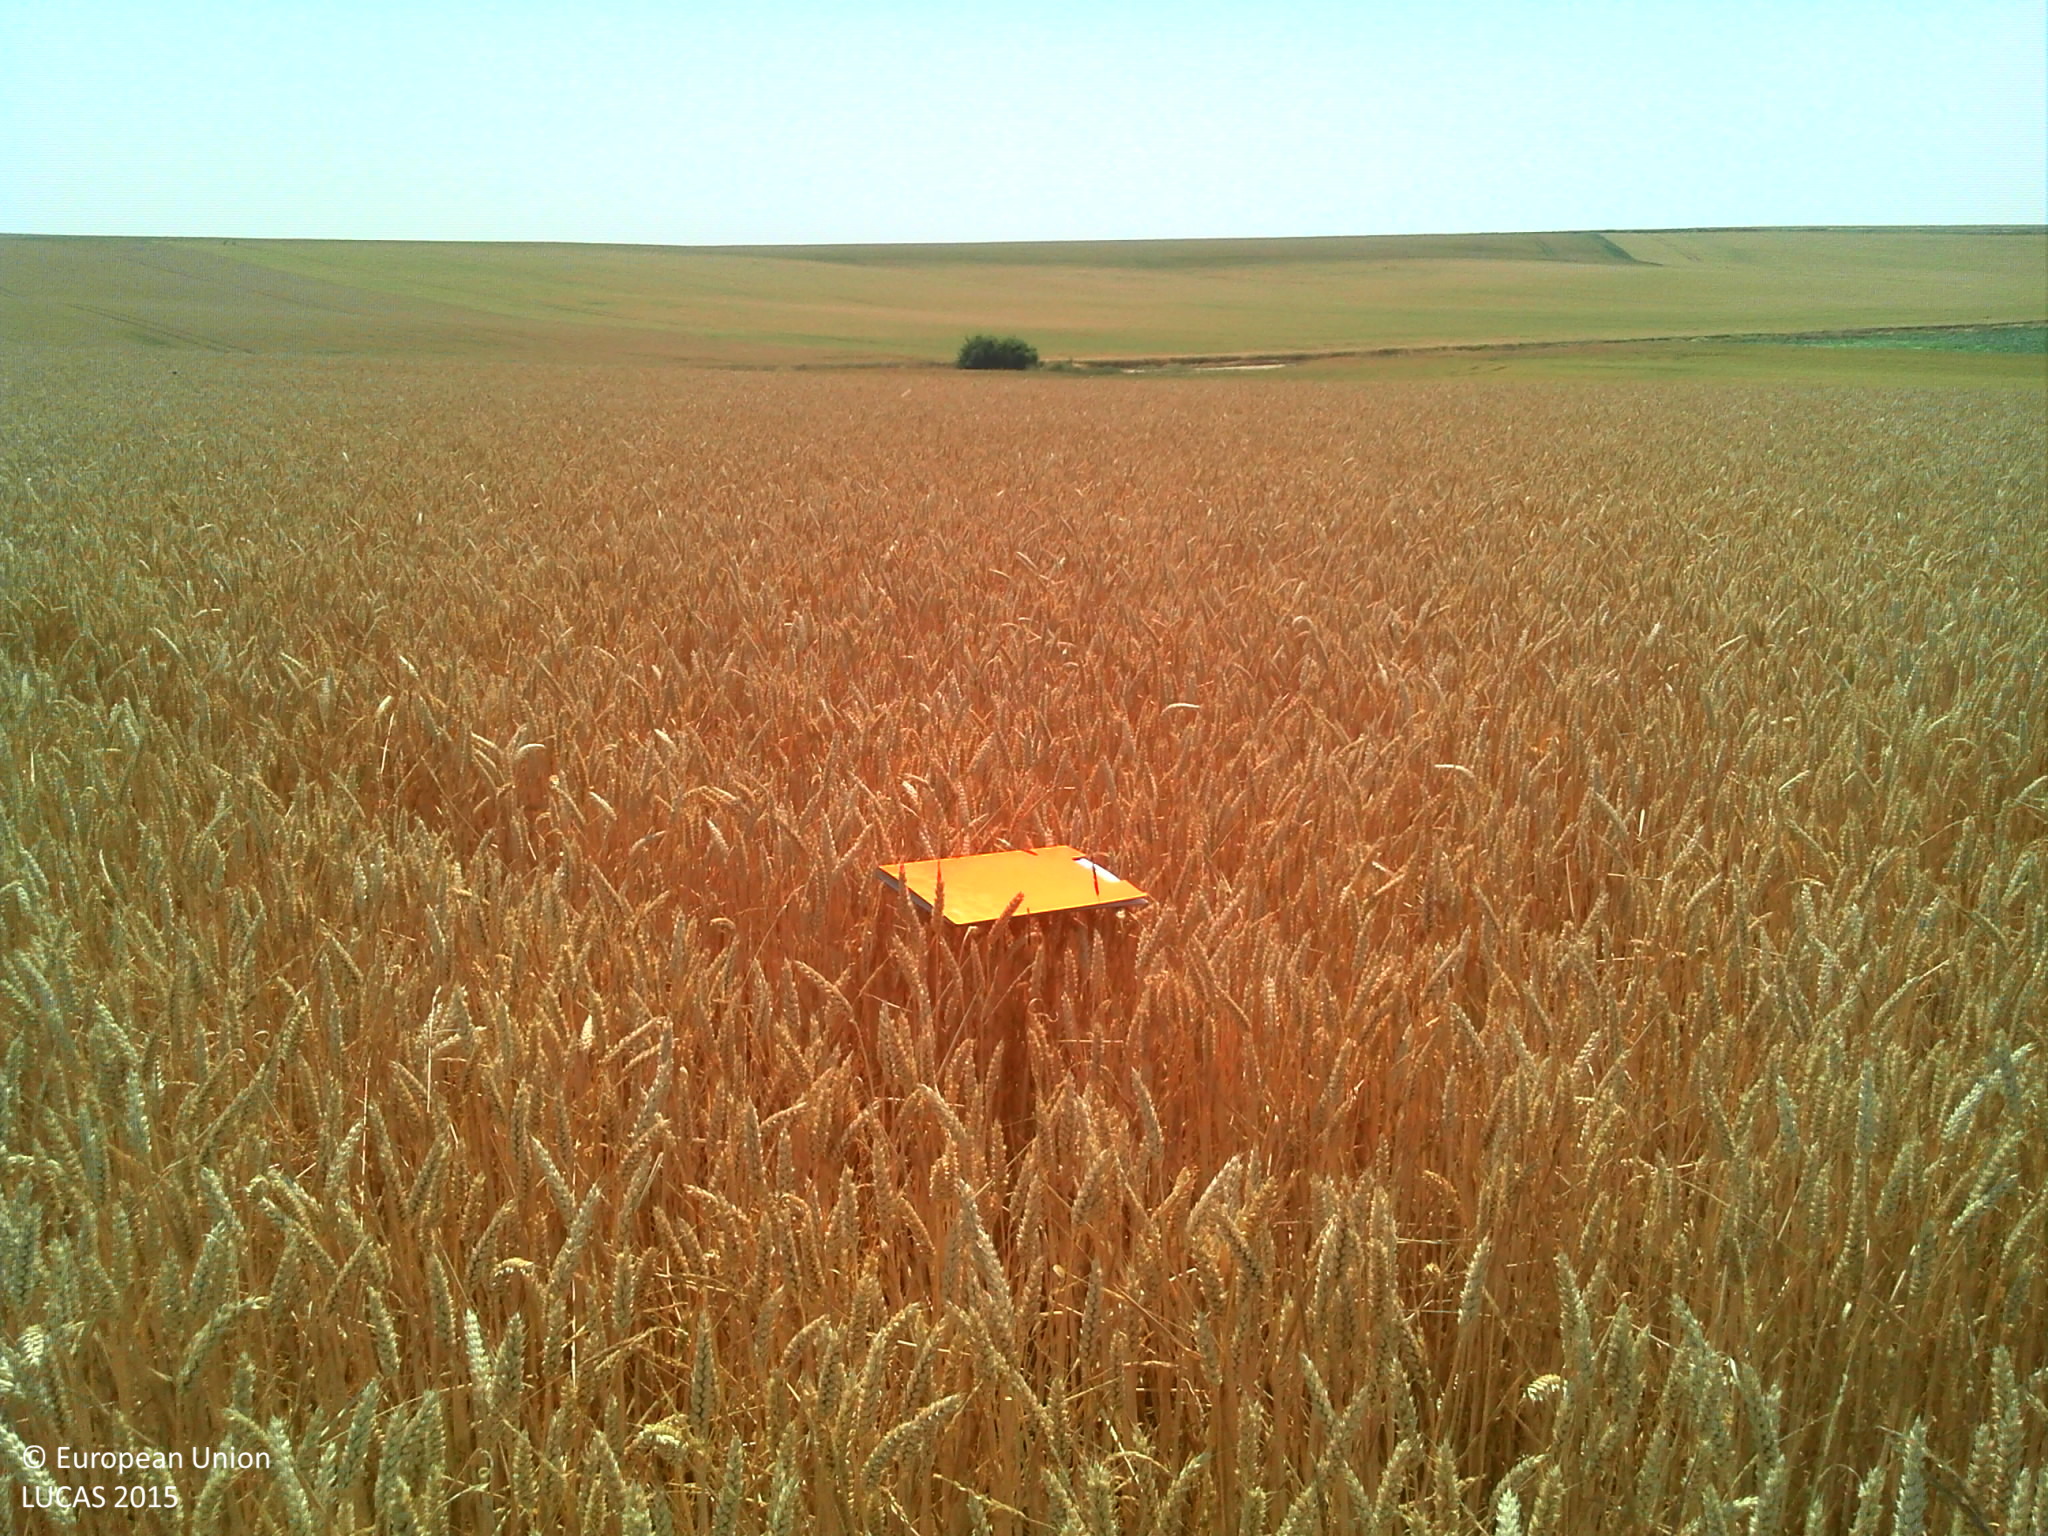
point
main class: Cropland
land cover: Common wheat
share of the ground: > 75 %
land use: Agriculture (excluding fallow land and kitchen gardens)
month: July
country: FR
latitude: 49.1562
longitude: 3.2871
